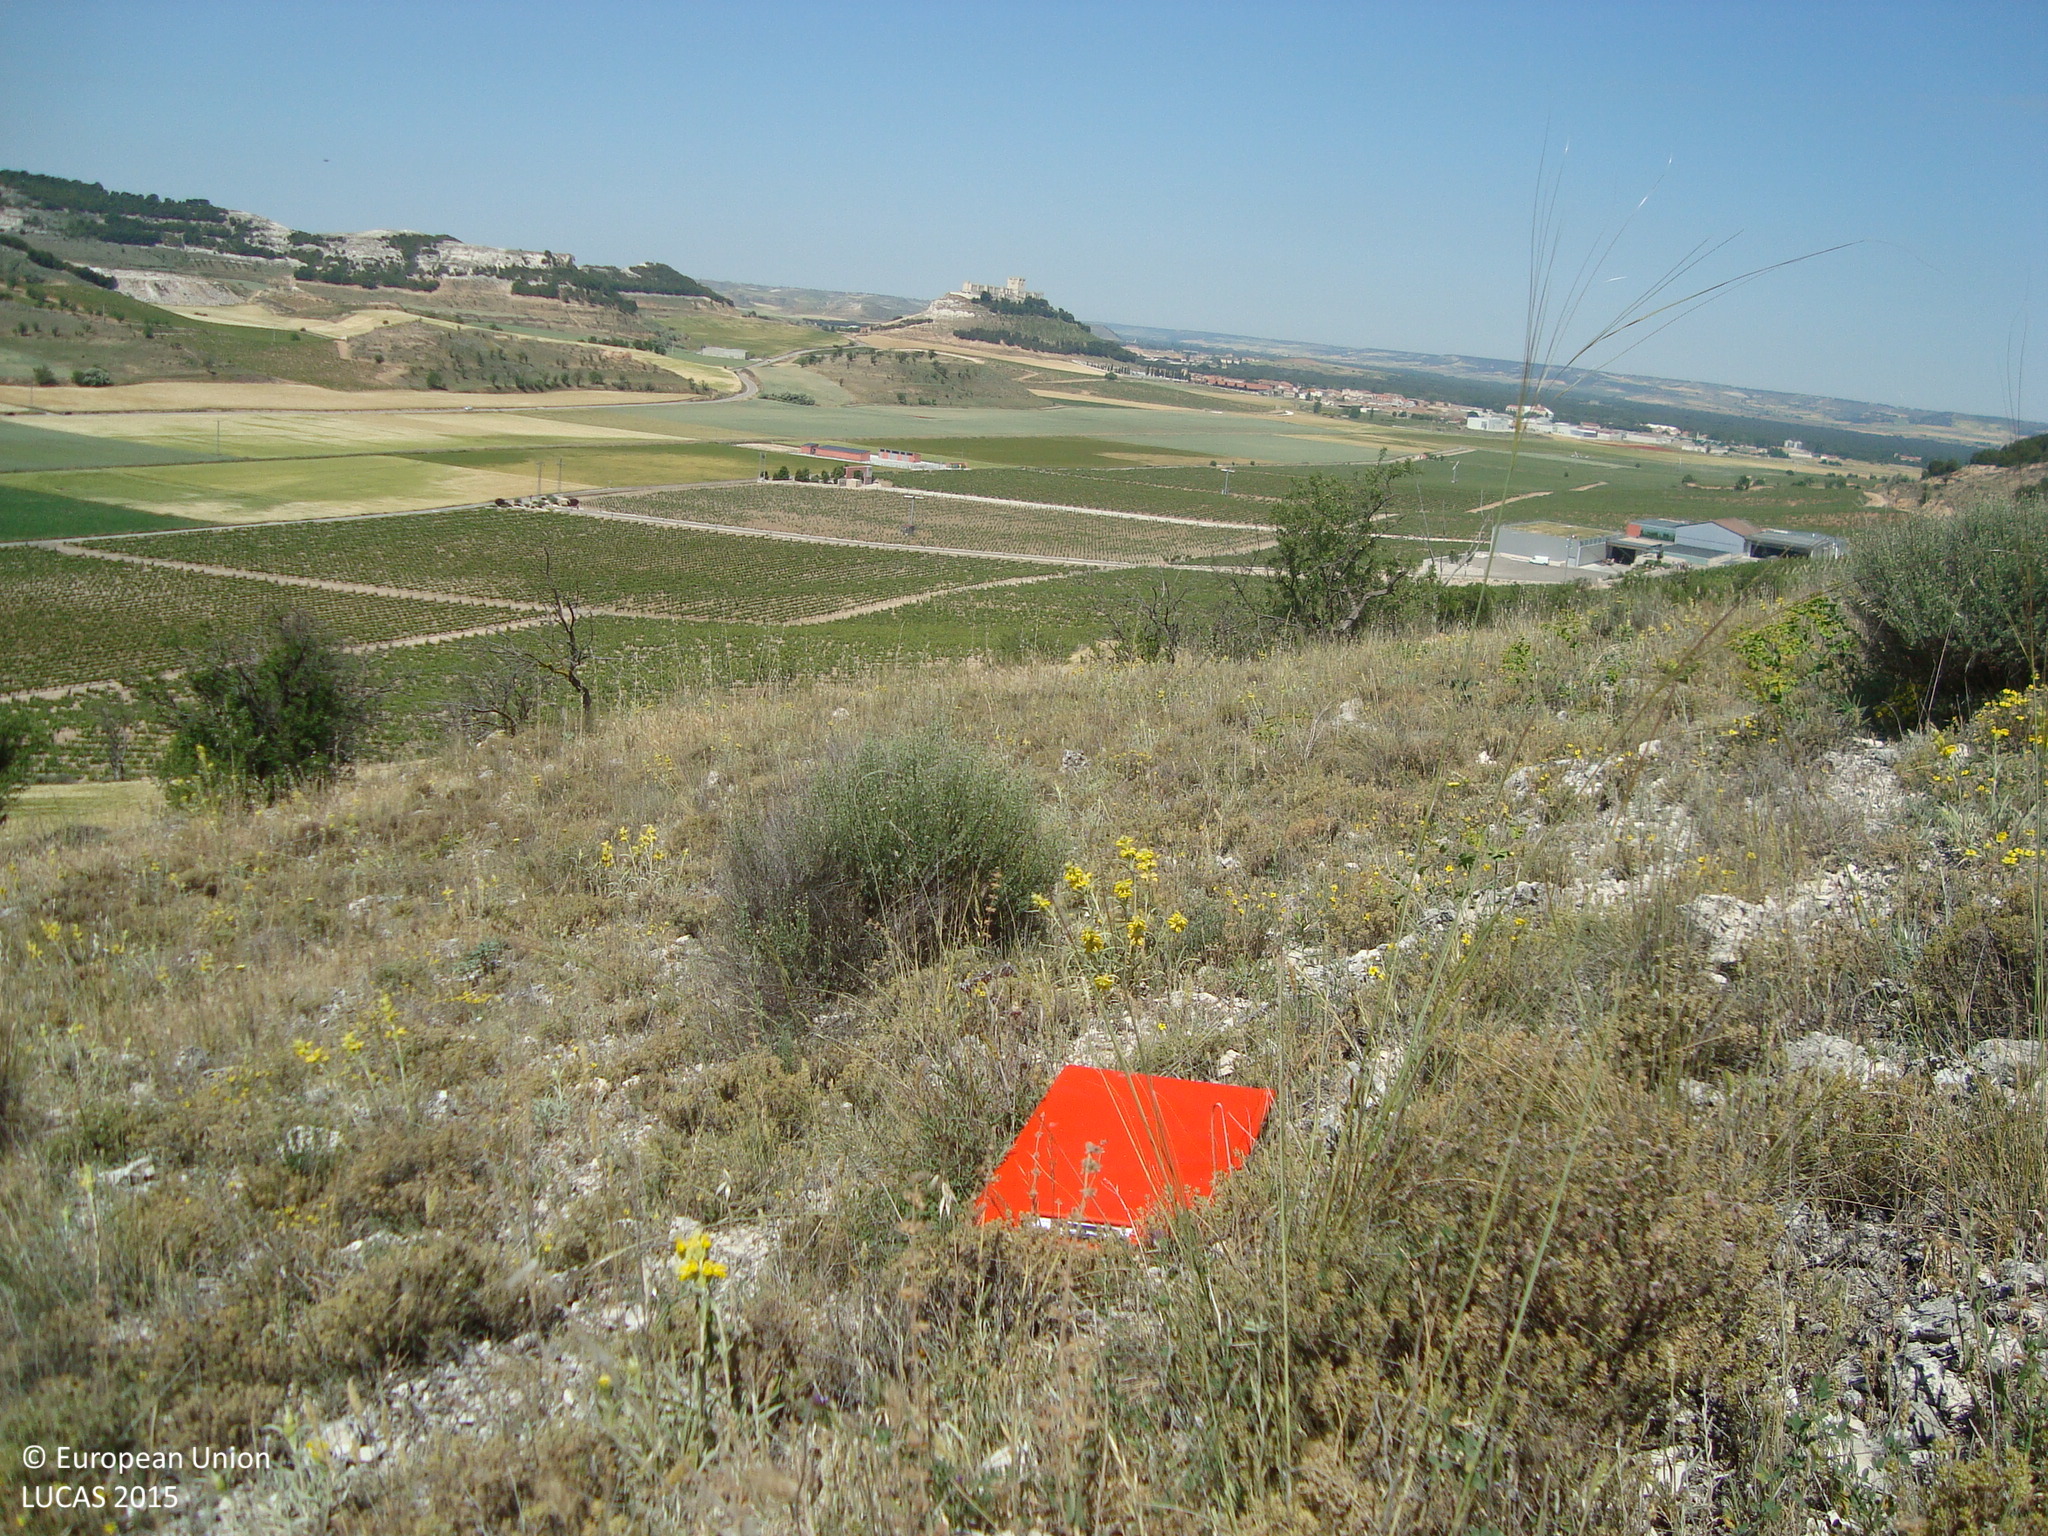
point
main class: Shrubland
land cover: Shrubland without tree cover
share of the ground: 50 - 75 %
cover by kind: shrubs 70 %, unconsolidated bare surface 20 %, herbaceous plants 10 %
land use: Semi-natural and natural areas not in use
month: May
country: ES
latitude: 41.5915
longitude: -4.0815
